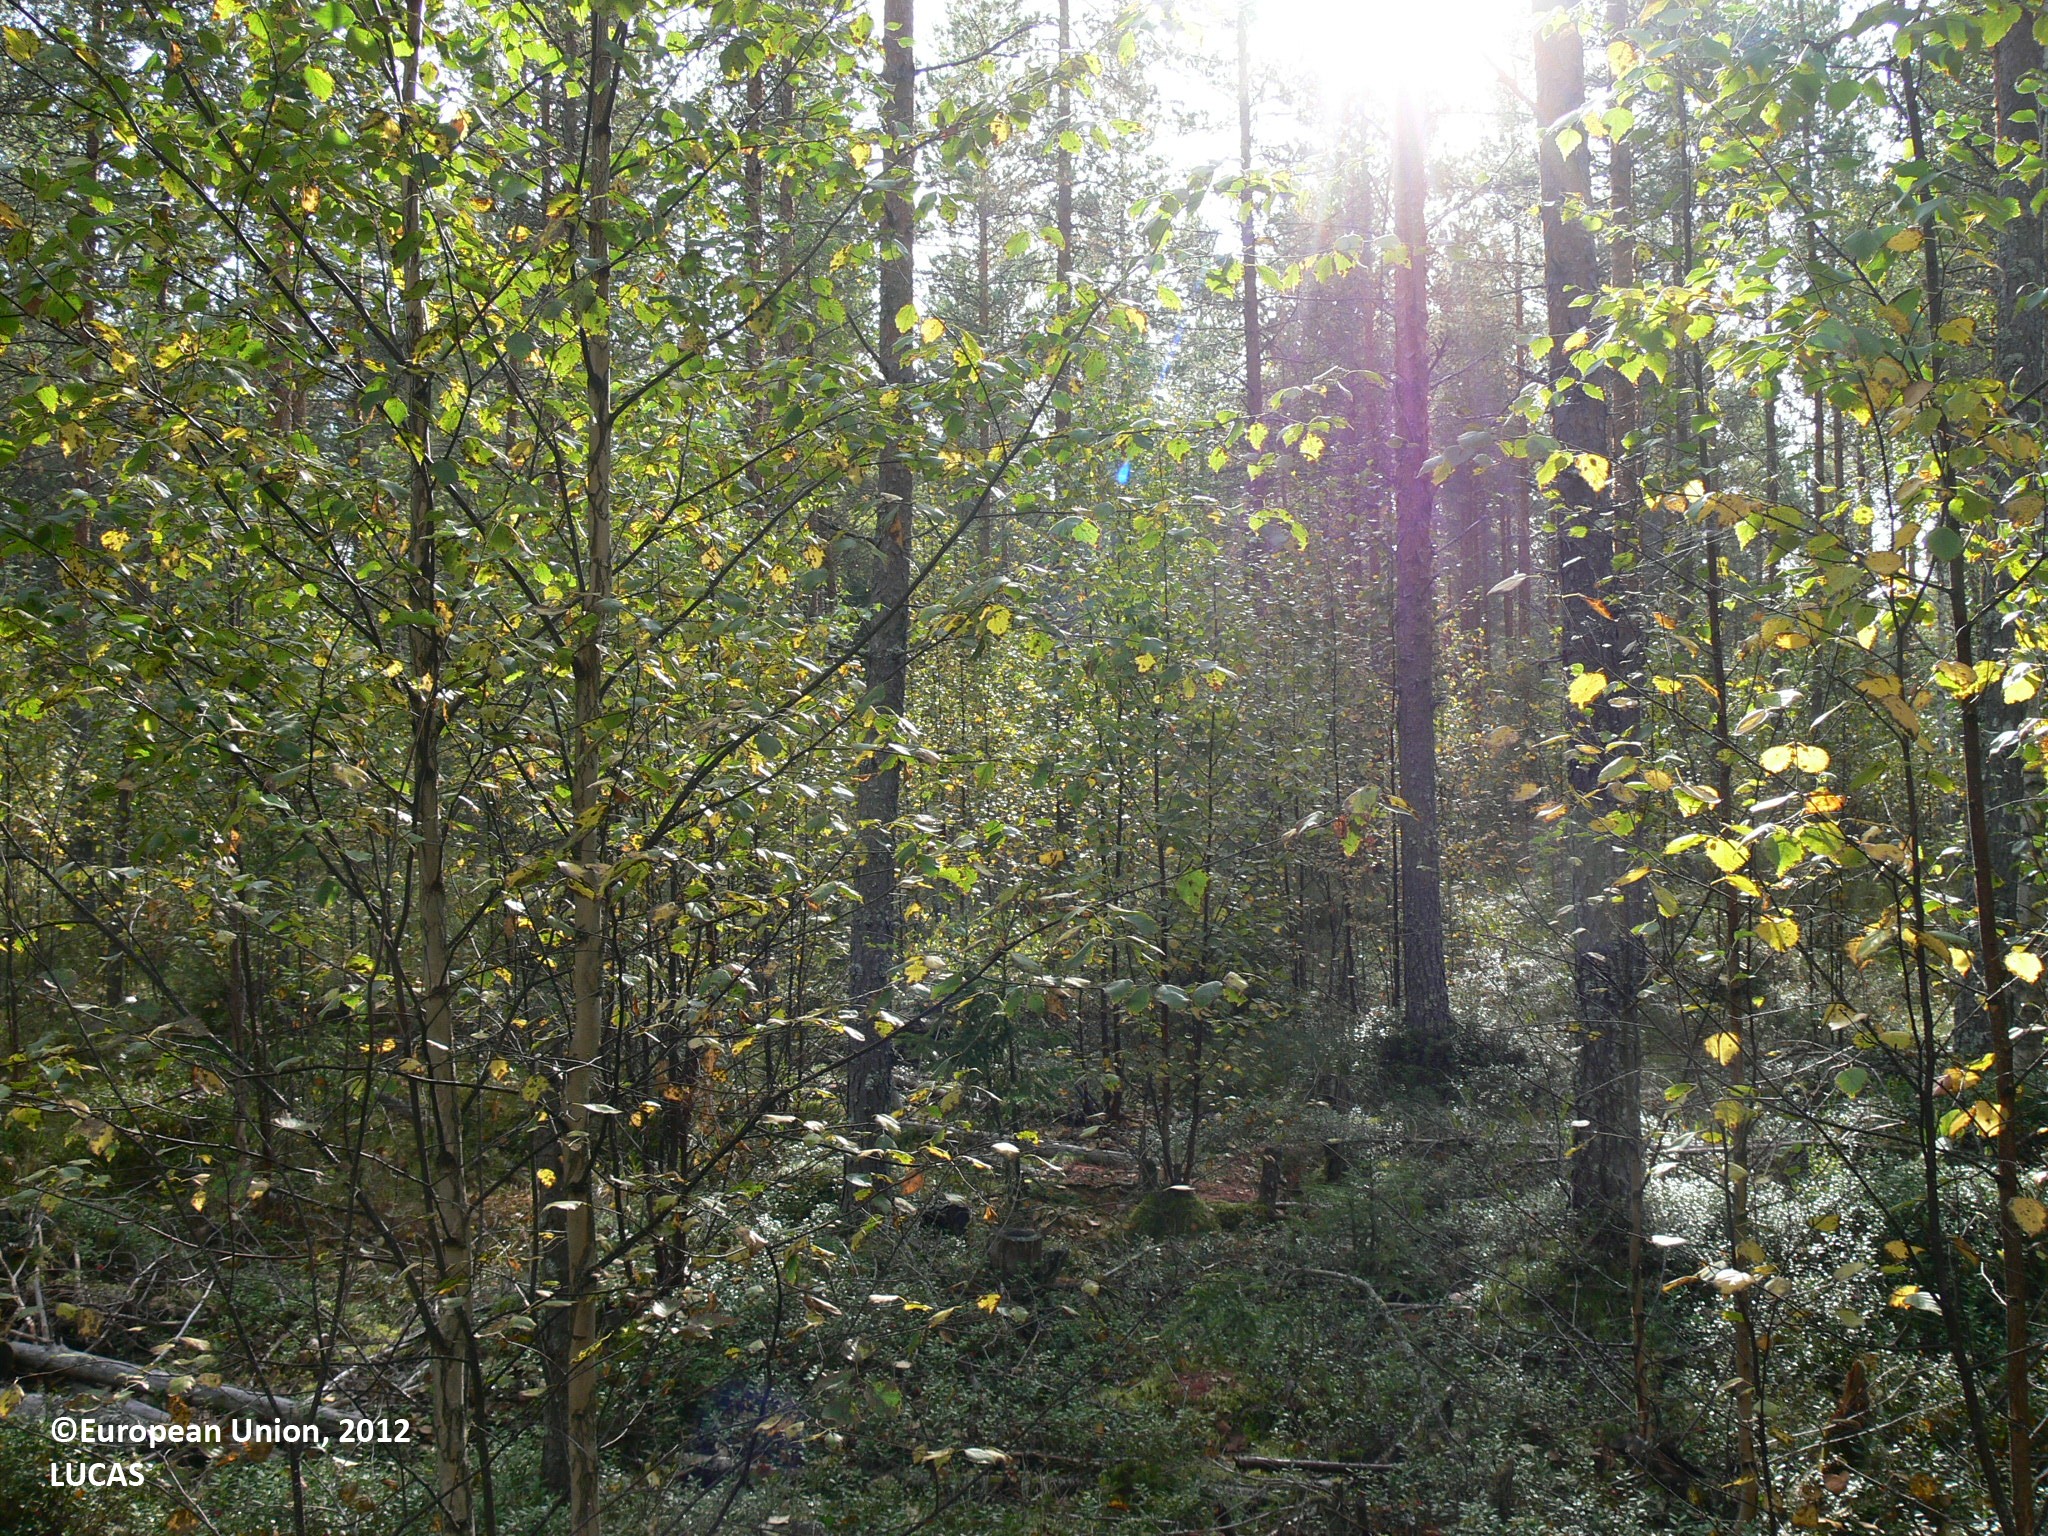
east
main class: Woodland
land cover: Pine dominated mixed woodland
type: boreal forest
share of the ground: > 75 %
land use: Forestry
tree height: > 5 m
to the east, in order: Pine dominated mixed woodland; Pine dominated coniferous woodland; Ditches and canals; Pine dominated coniferous woodland; Ditches and canals; Pine dominated mixed woodland; Pine dominated coniferous woodland; Other mixed woodland; Ditches and canals; Other mixed woodland
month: September
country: FI
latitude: 63.1249
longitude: 30.1055
